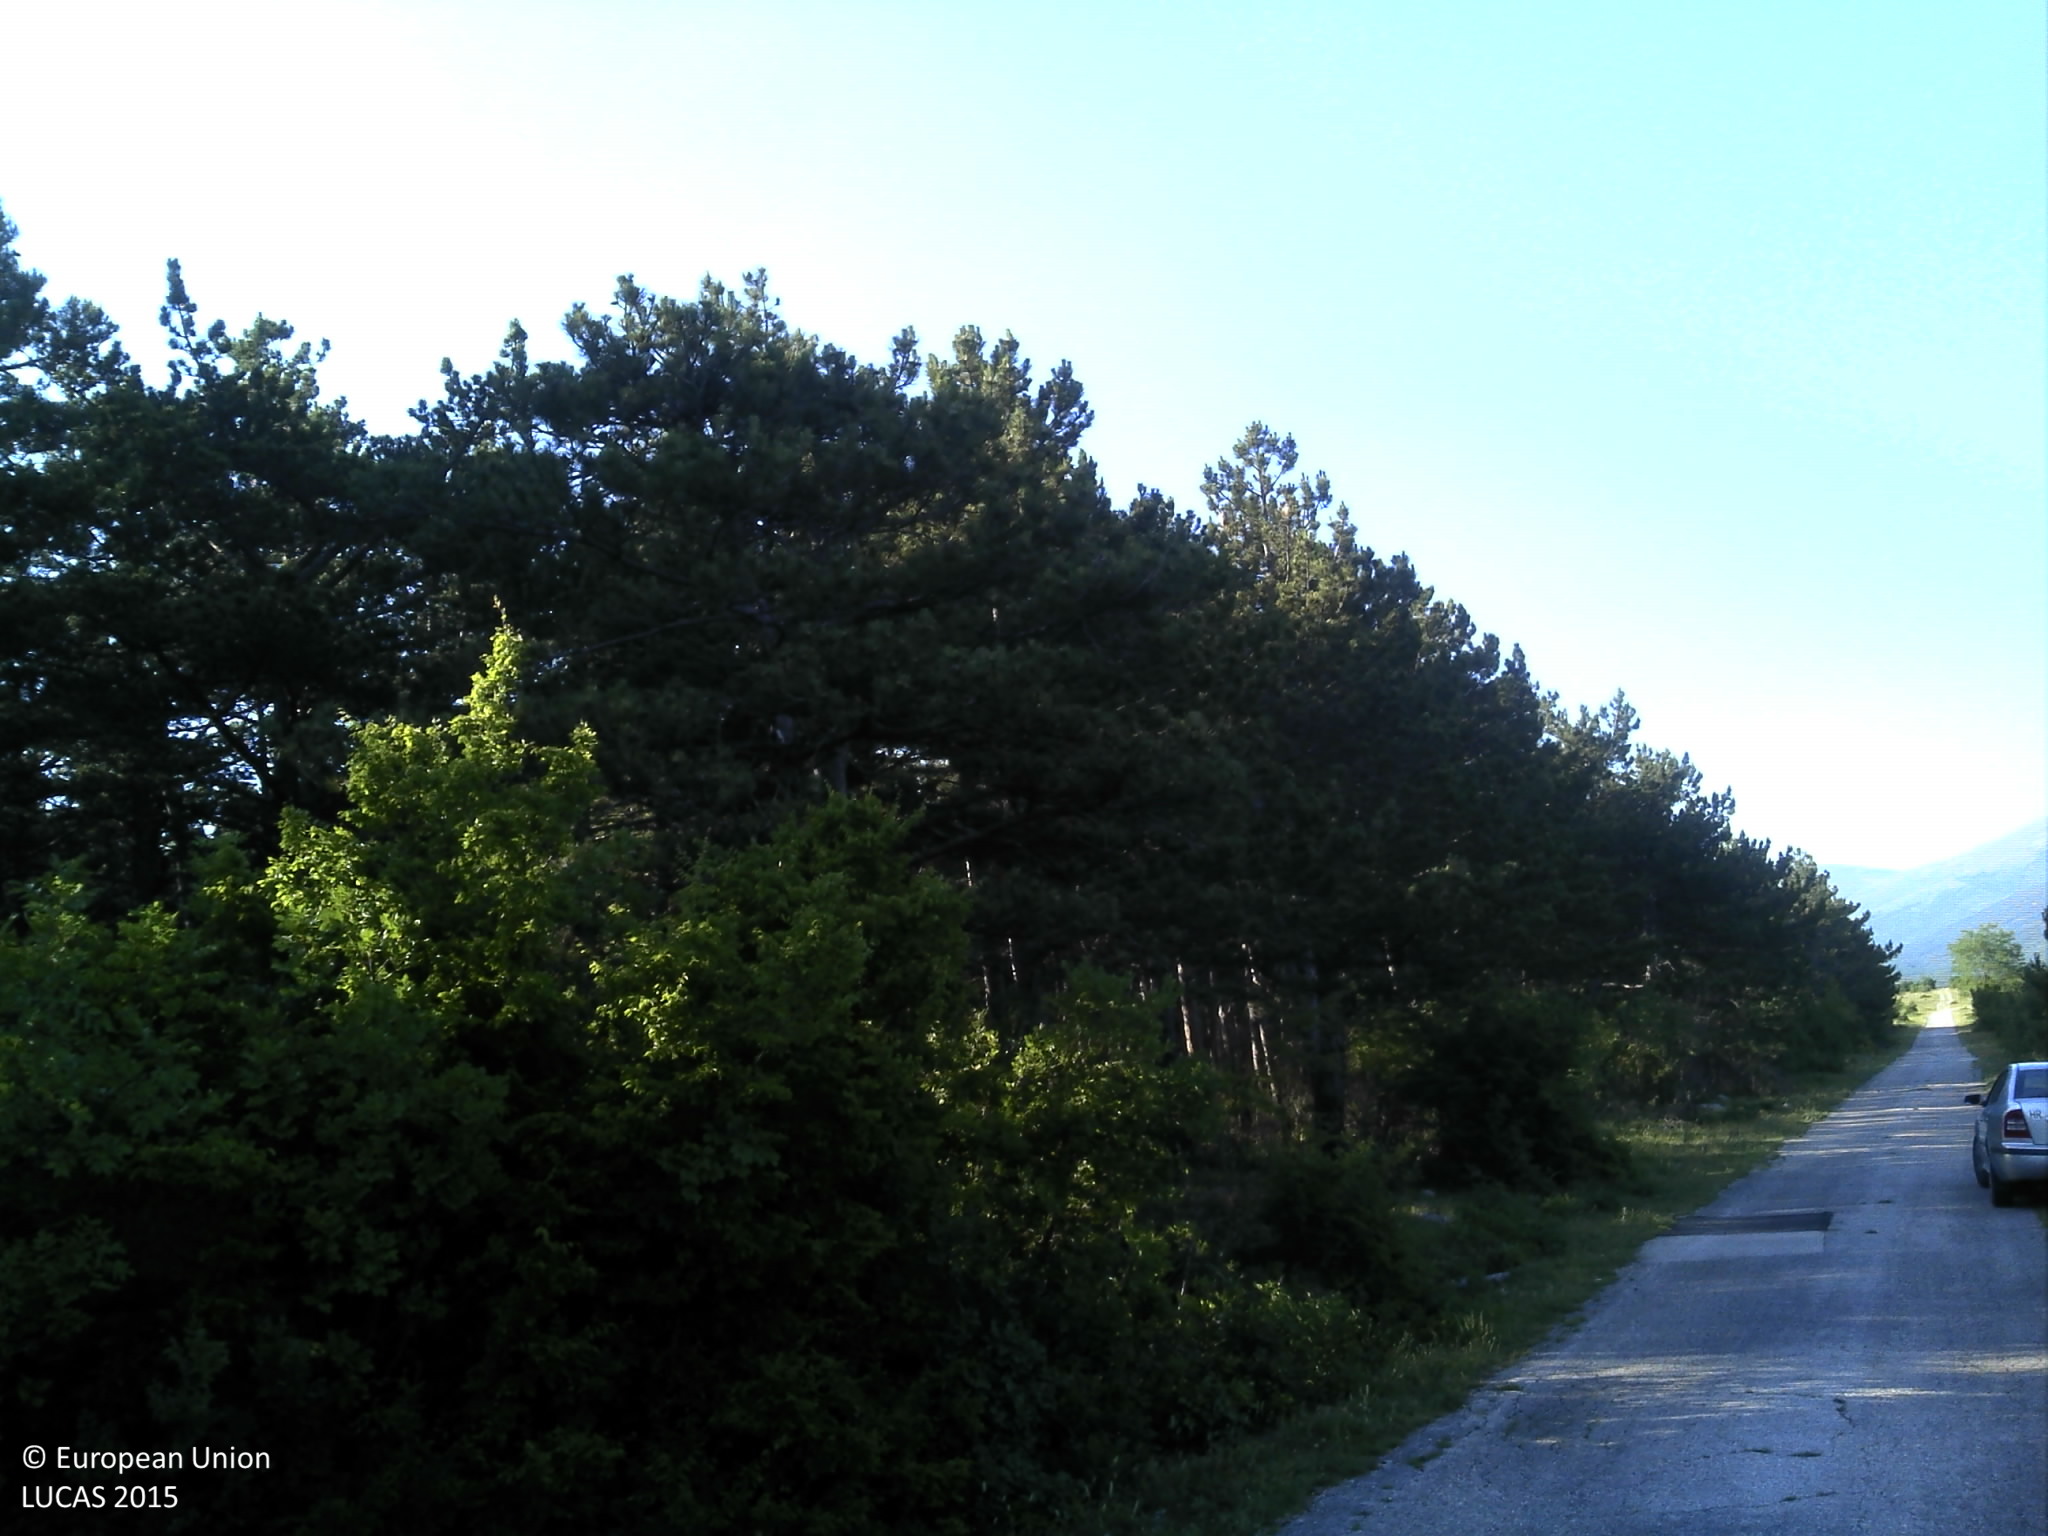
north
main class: Woodland
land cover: Pine dominated coniferous woodland
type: coniferous forest of the mediterranean region
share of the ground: > 75 %
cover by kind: coniferous forest trees 90 %, shrubs 5 %, herbaceous plants 5 %
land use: Forestry
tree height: > 5 m
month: June
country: HR
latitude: 43.9713
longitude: 16.4120
